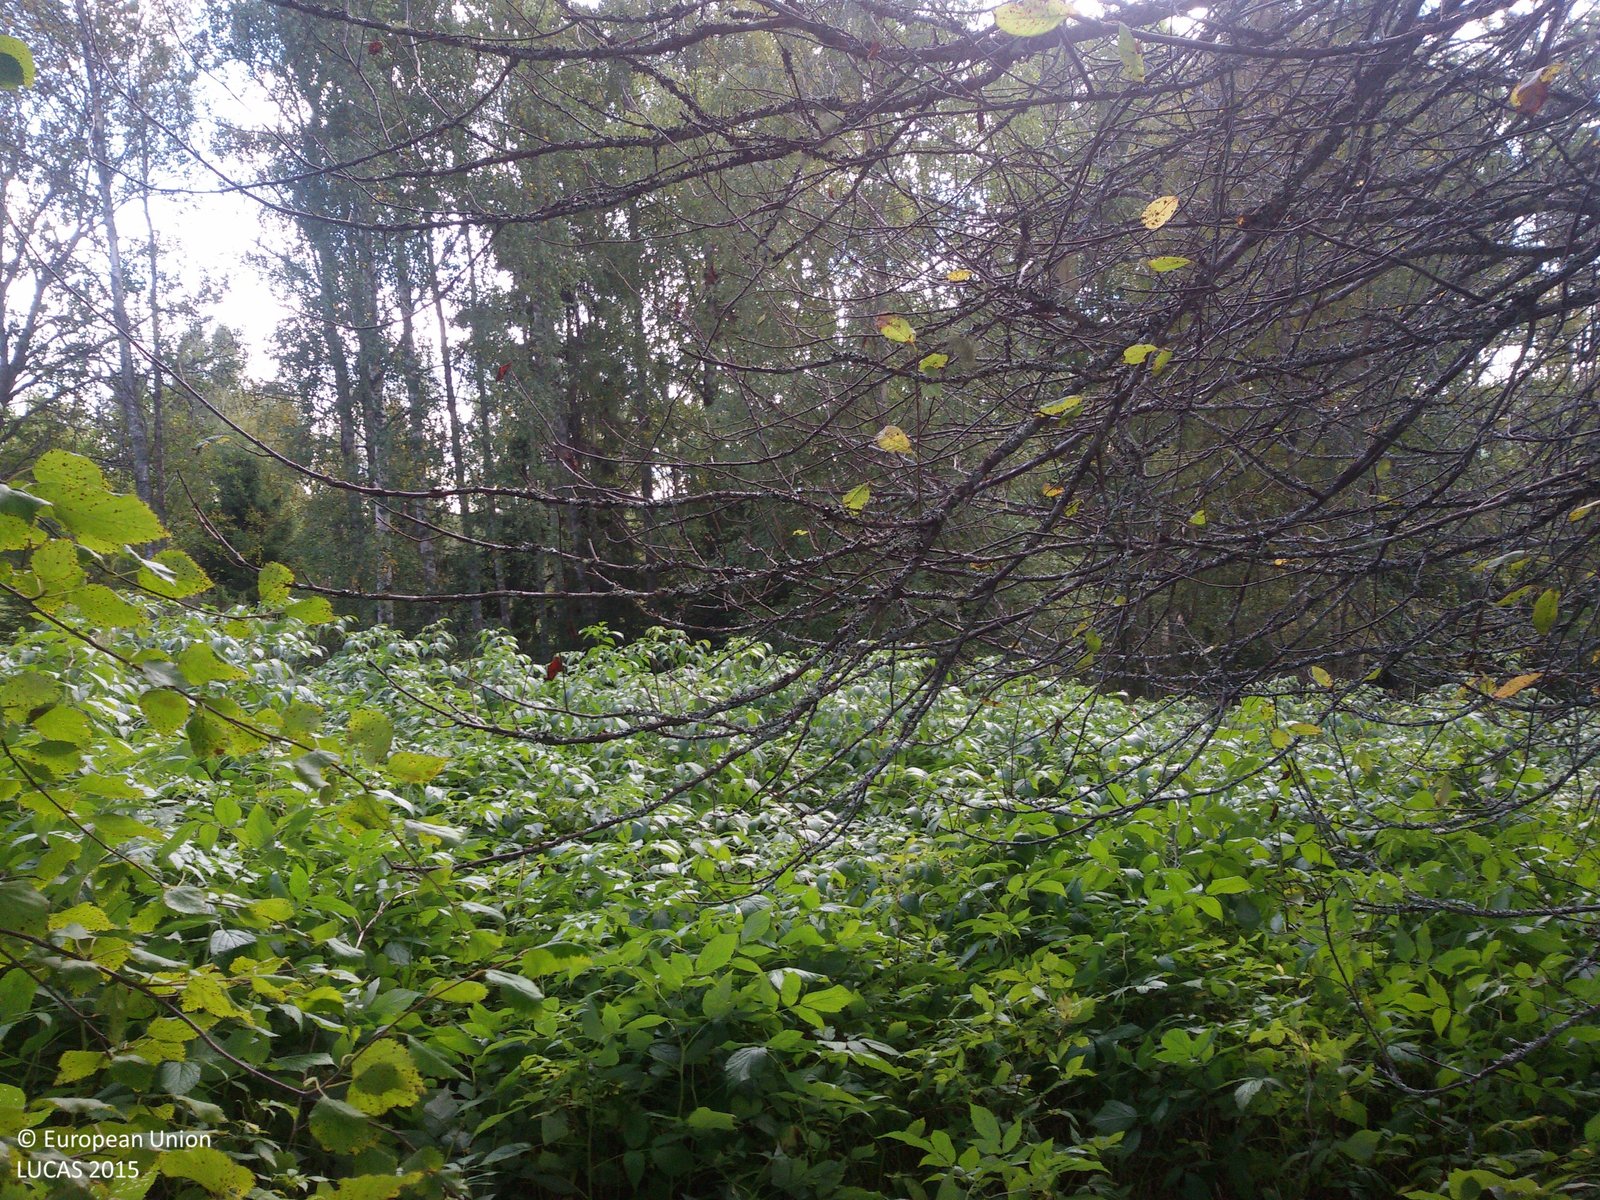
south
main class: Woodland
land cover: Broadleaved woodland
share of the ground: > 75 %
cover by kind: broadleaved forest trees 80 %, herbaceous plants 20 %
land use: Semi-natural and natural areas not in use
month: September
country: SE
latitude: 60.7546
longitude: 15.1431
